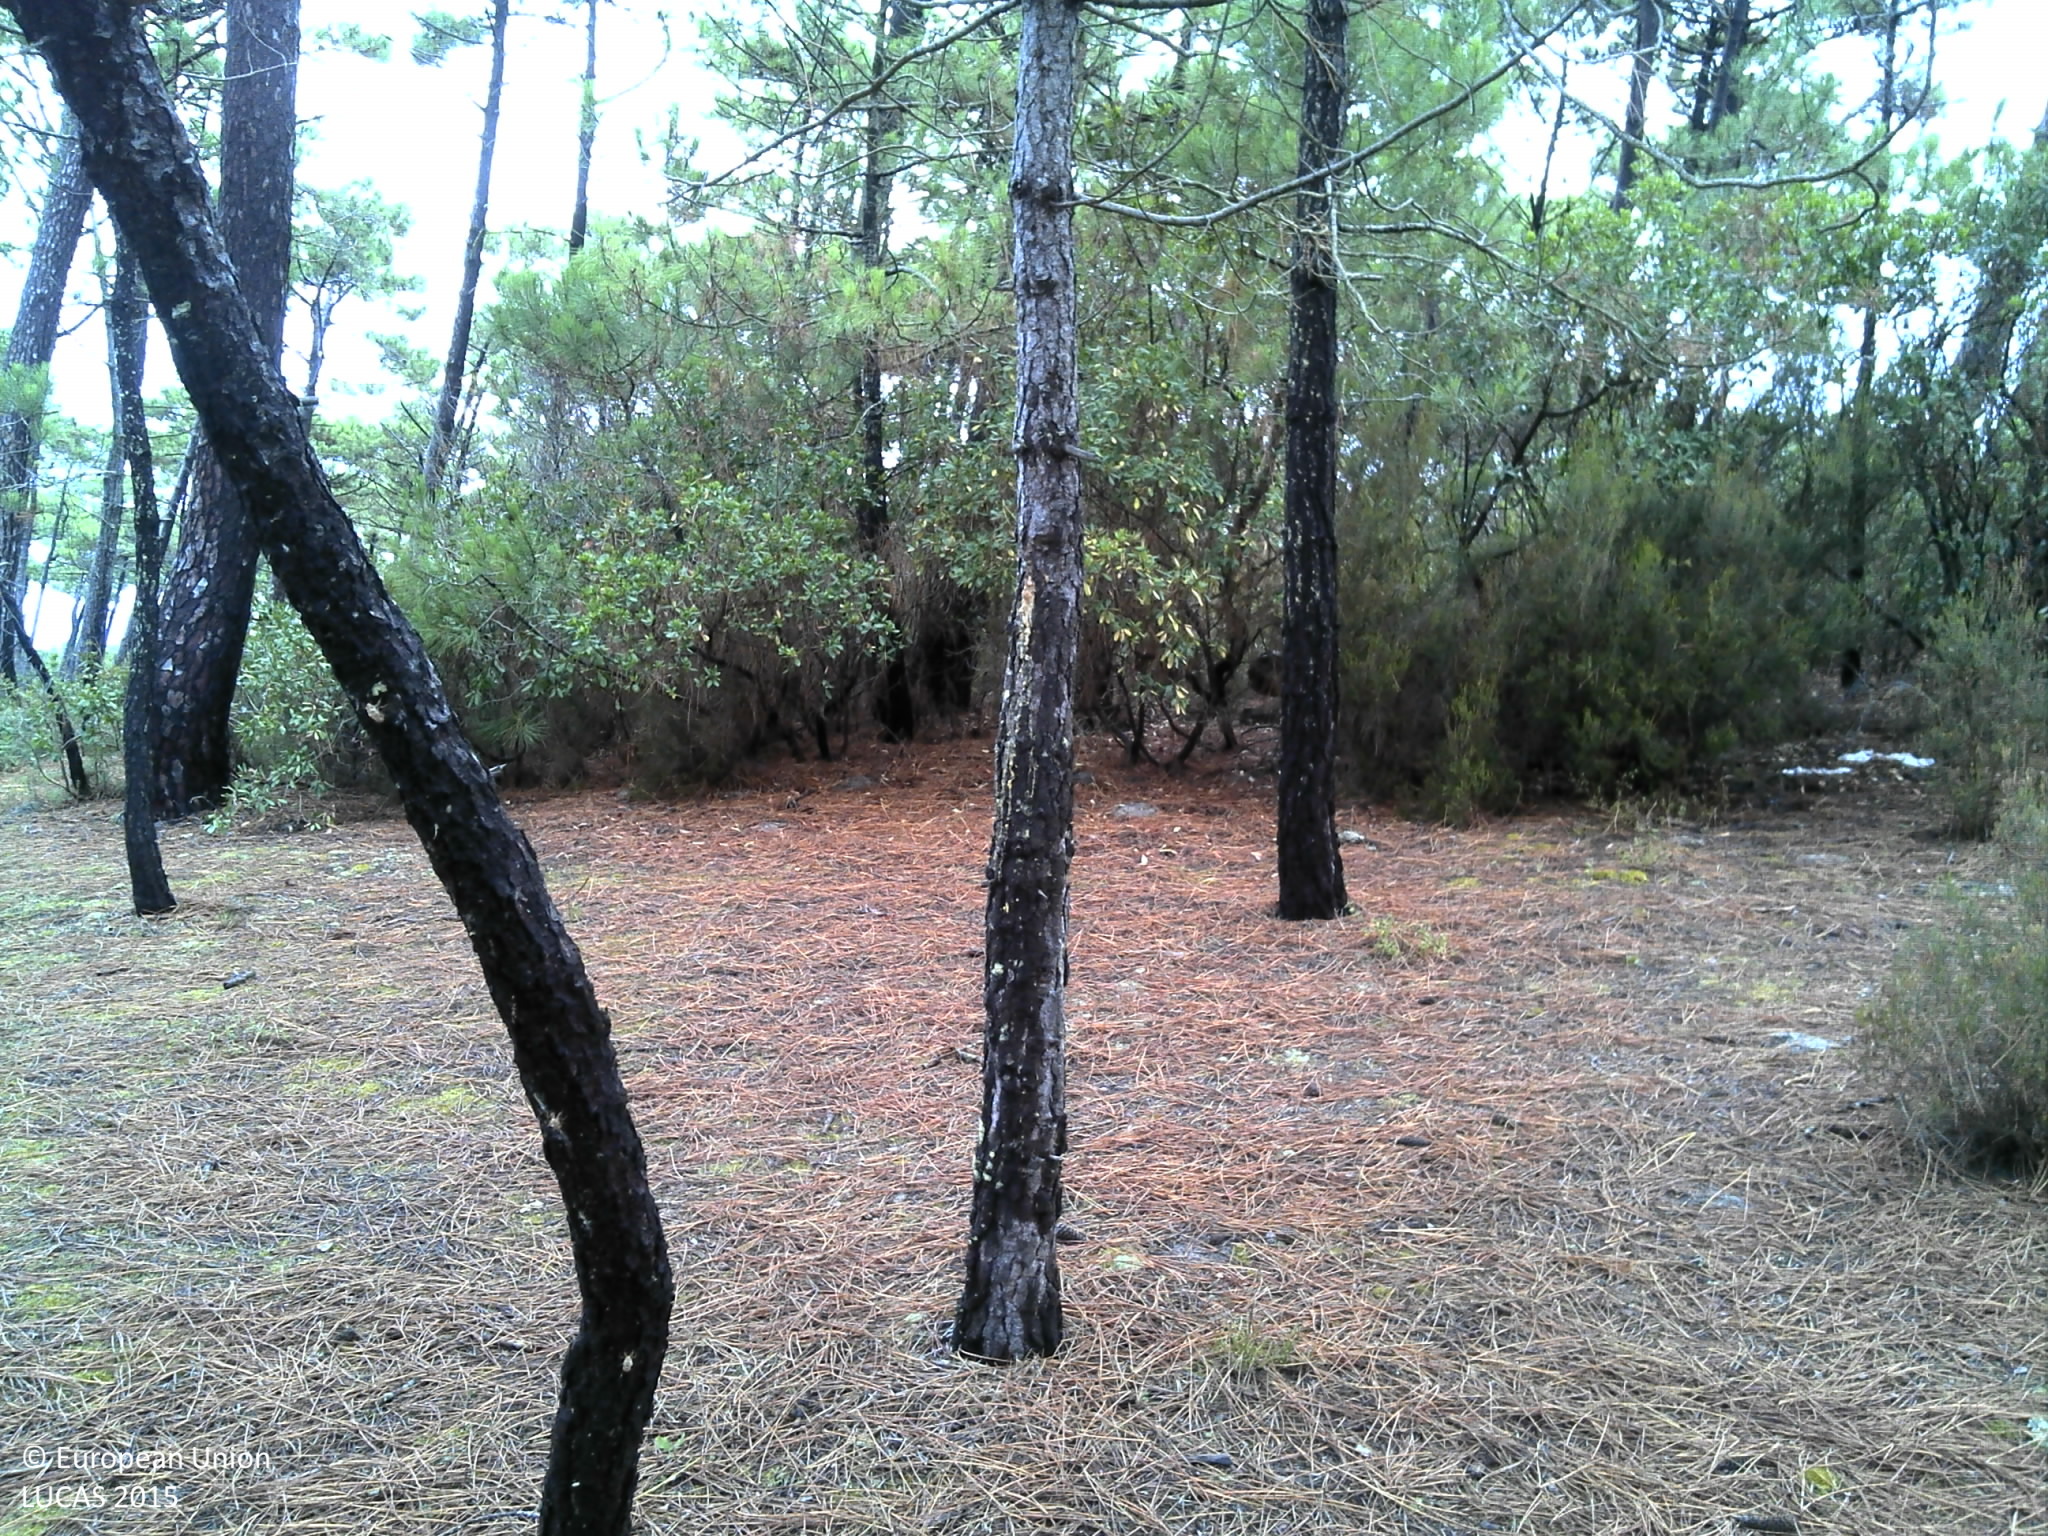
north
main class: Woodland
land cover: Pine dominated coniferous woodland
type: coniferous forest of the mediterranean region
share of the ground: > 75 %
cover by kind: coniferous forest trees 60 %, shrubs 30 %, herbaceous plants 5 %, lichens and mosses 5 %
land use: Forestry
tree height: > 5 m
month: July
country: FR
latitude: 44.5566
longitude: -1.2403
